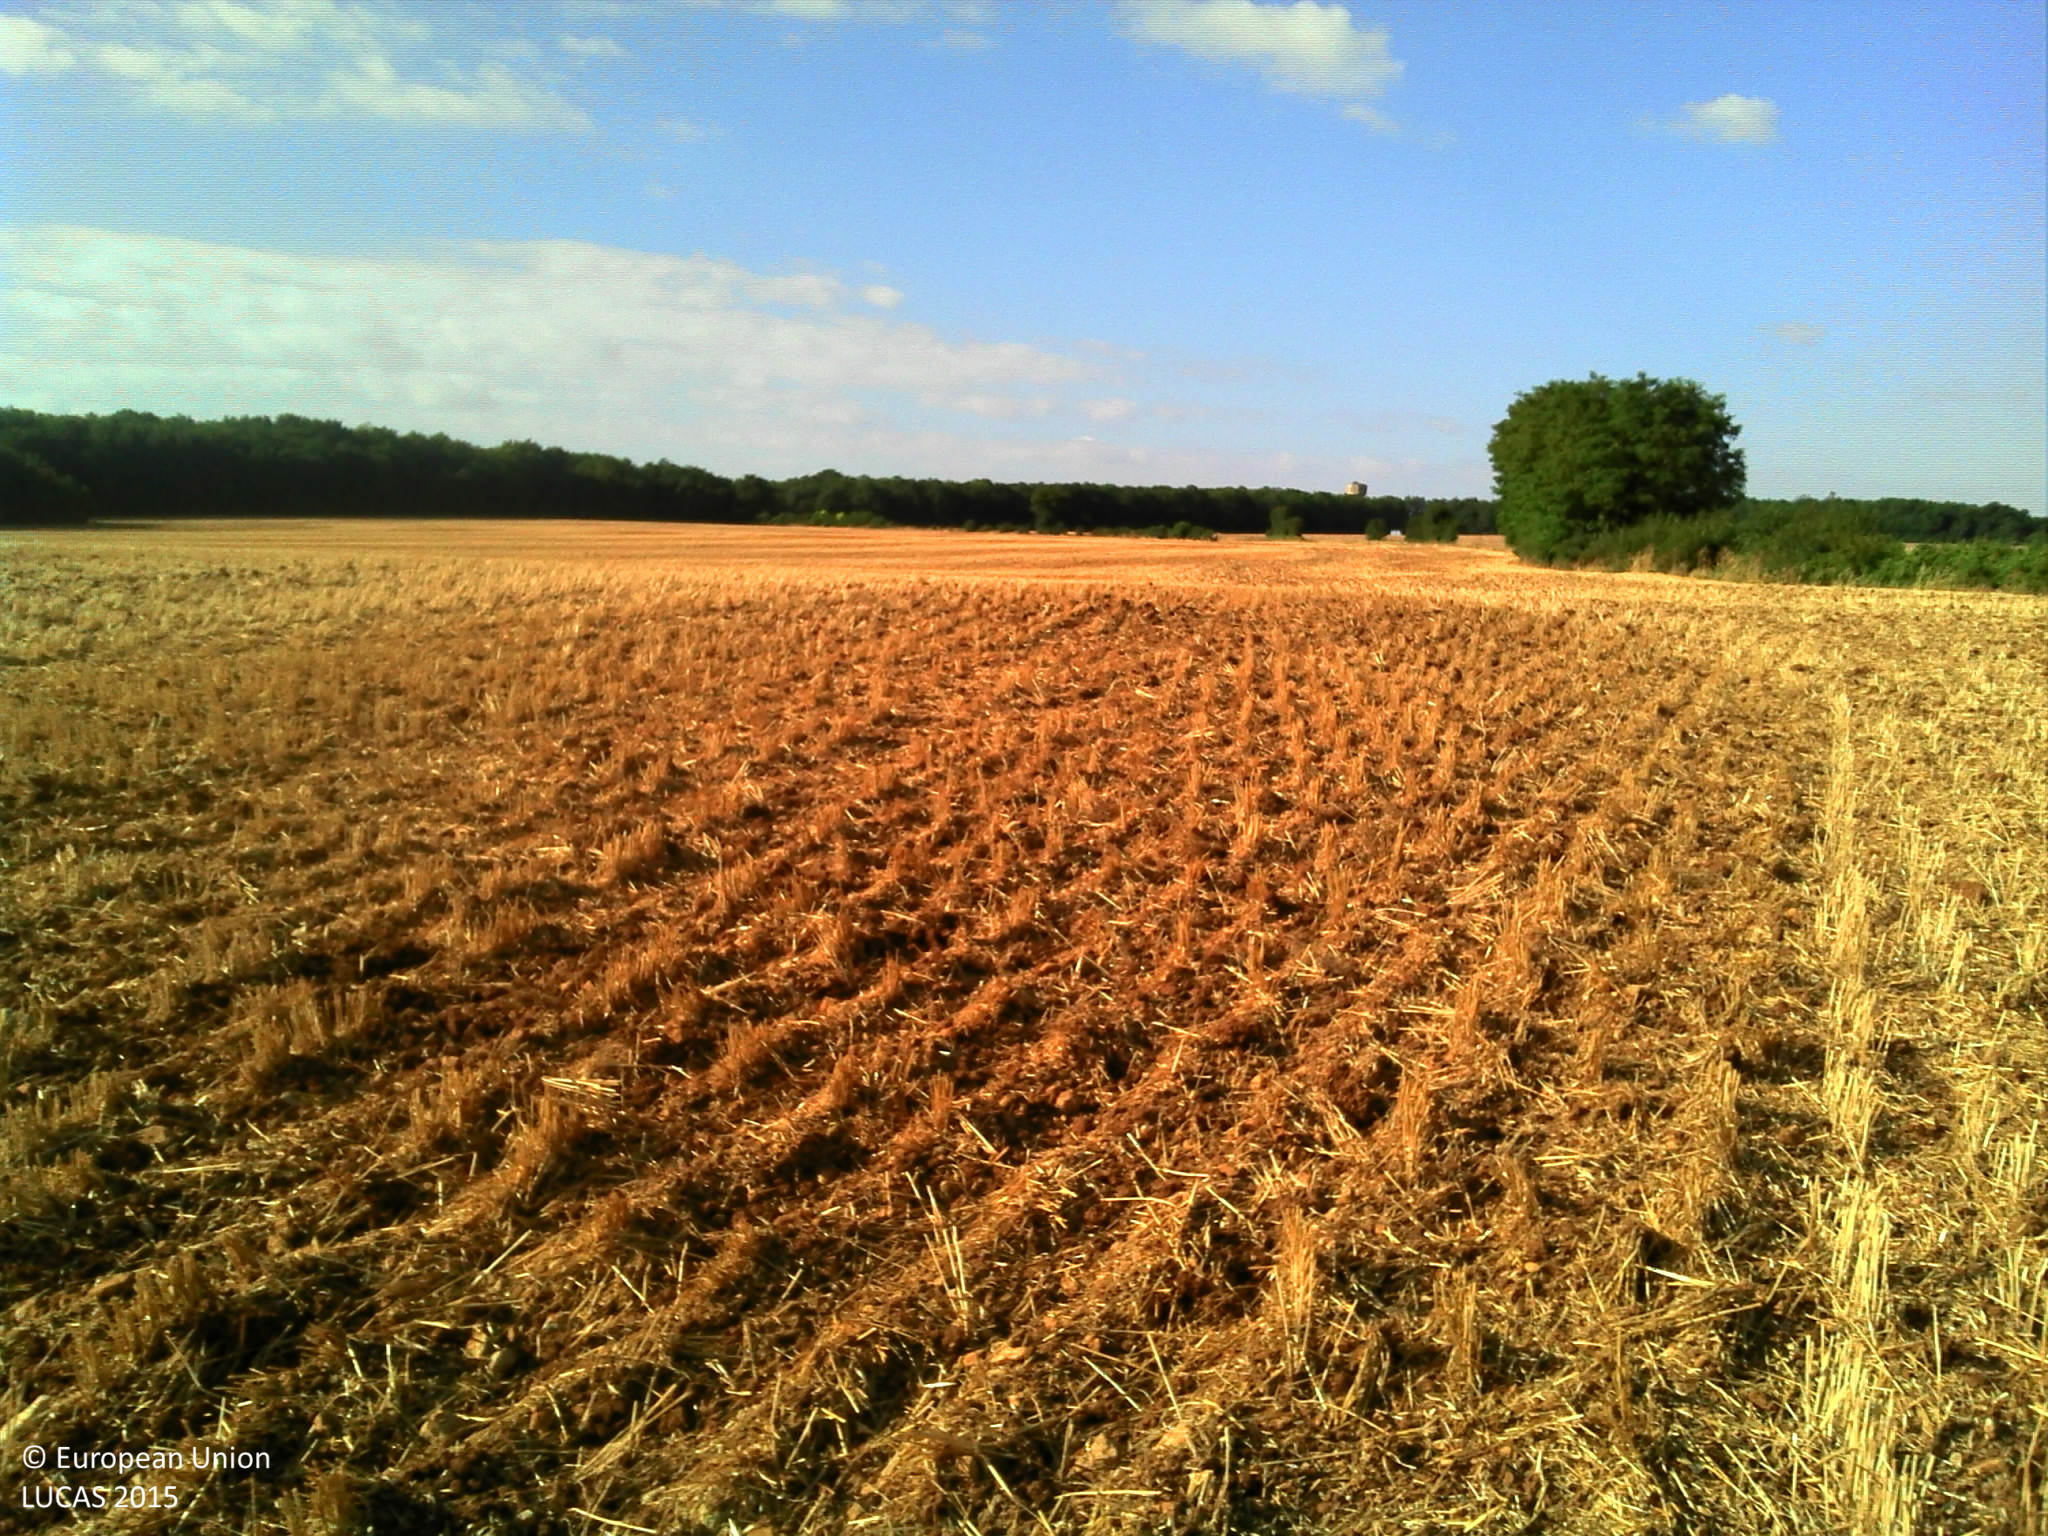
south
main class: Cropland
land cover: Common wheat
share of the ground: > 75 %
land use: Agriculture (excluding fallow land and kitchen gardens)
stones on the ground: 10 - 25 %
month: July
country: FR
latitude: 46.5908
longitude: 2.2013
